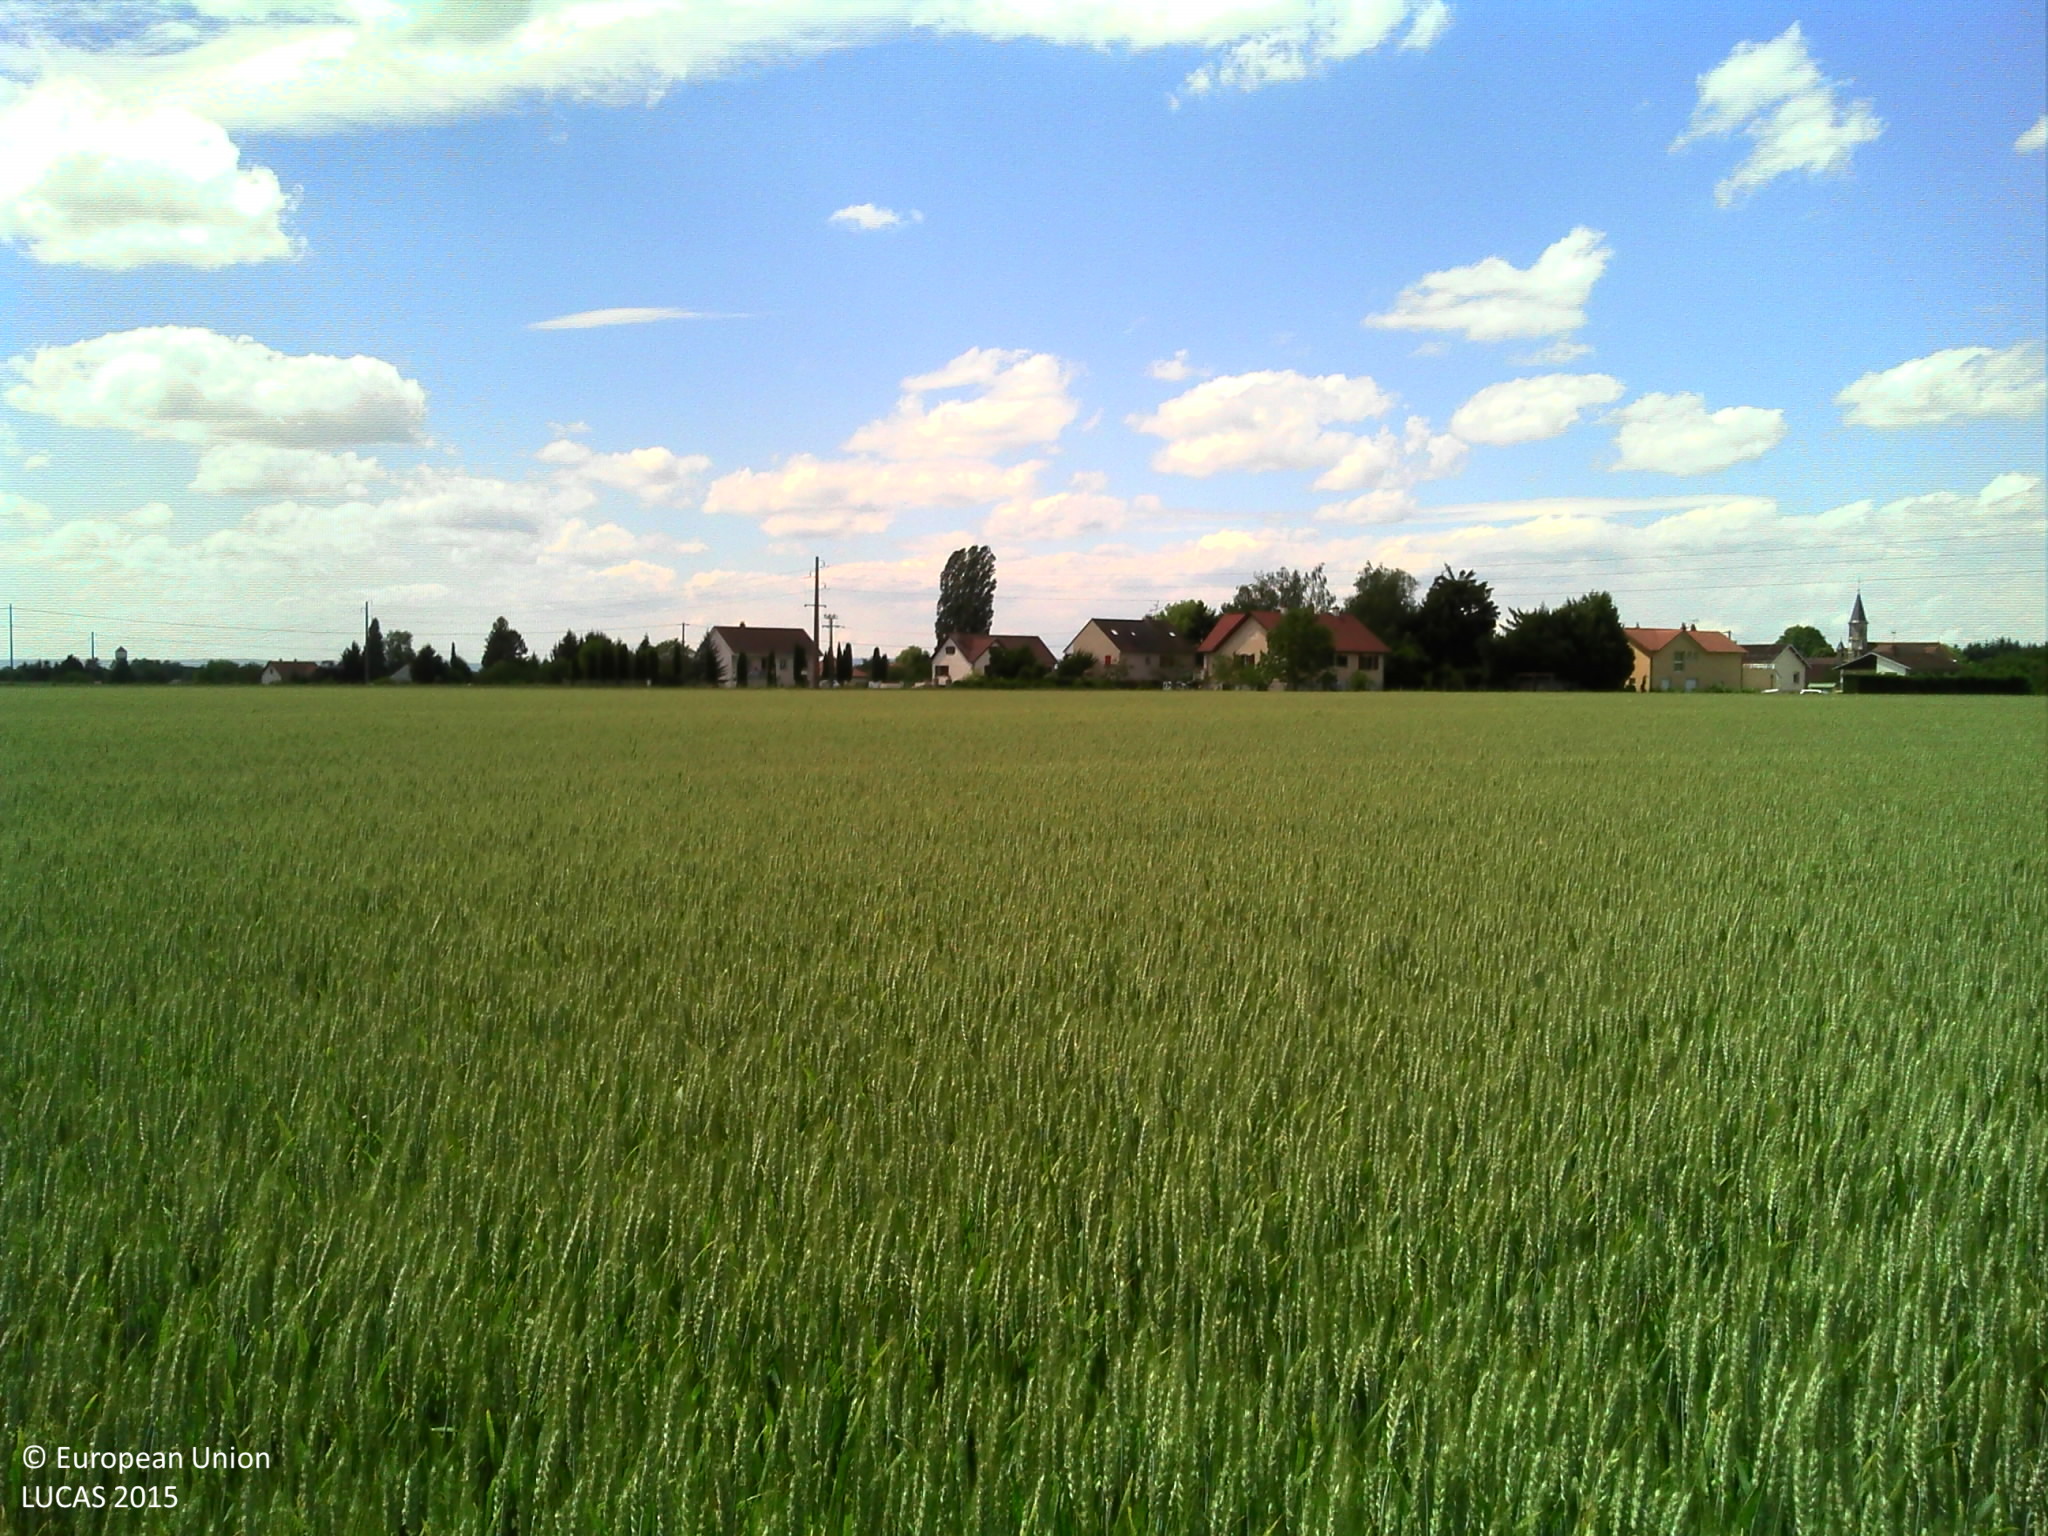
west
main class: Cropland
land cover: Common wheat
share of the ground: > 75 %
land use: Agriculture (excluding fallow land and kitchen gardens)
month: May
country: FR
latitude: 47.2561
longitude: 5.2570
